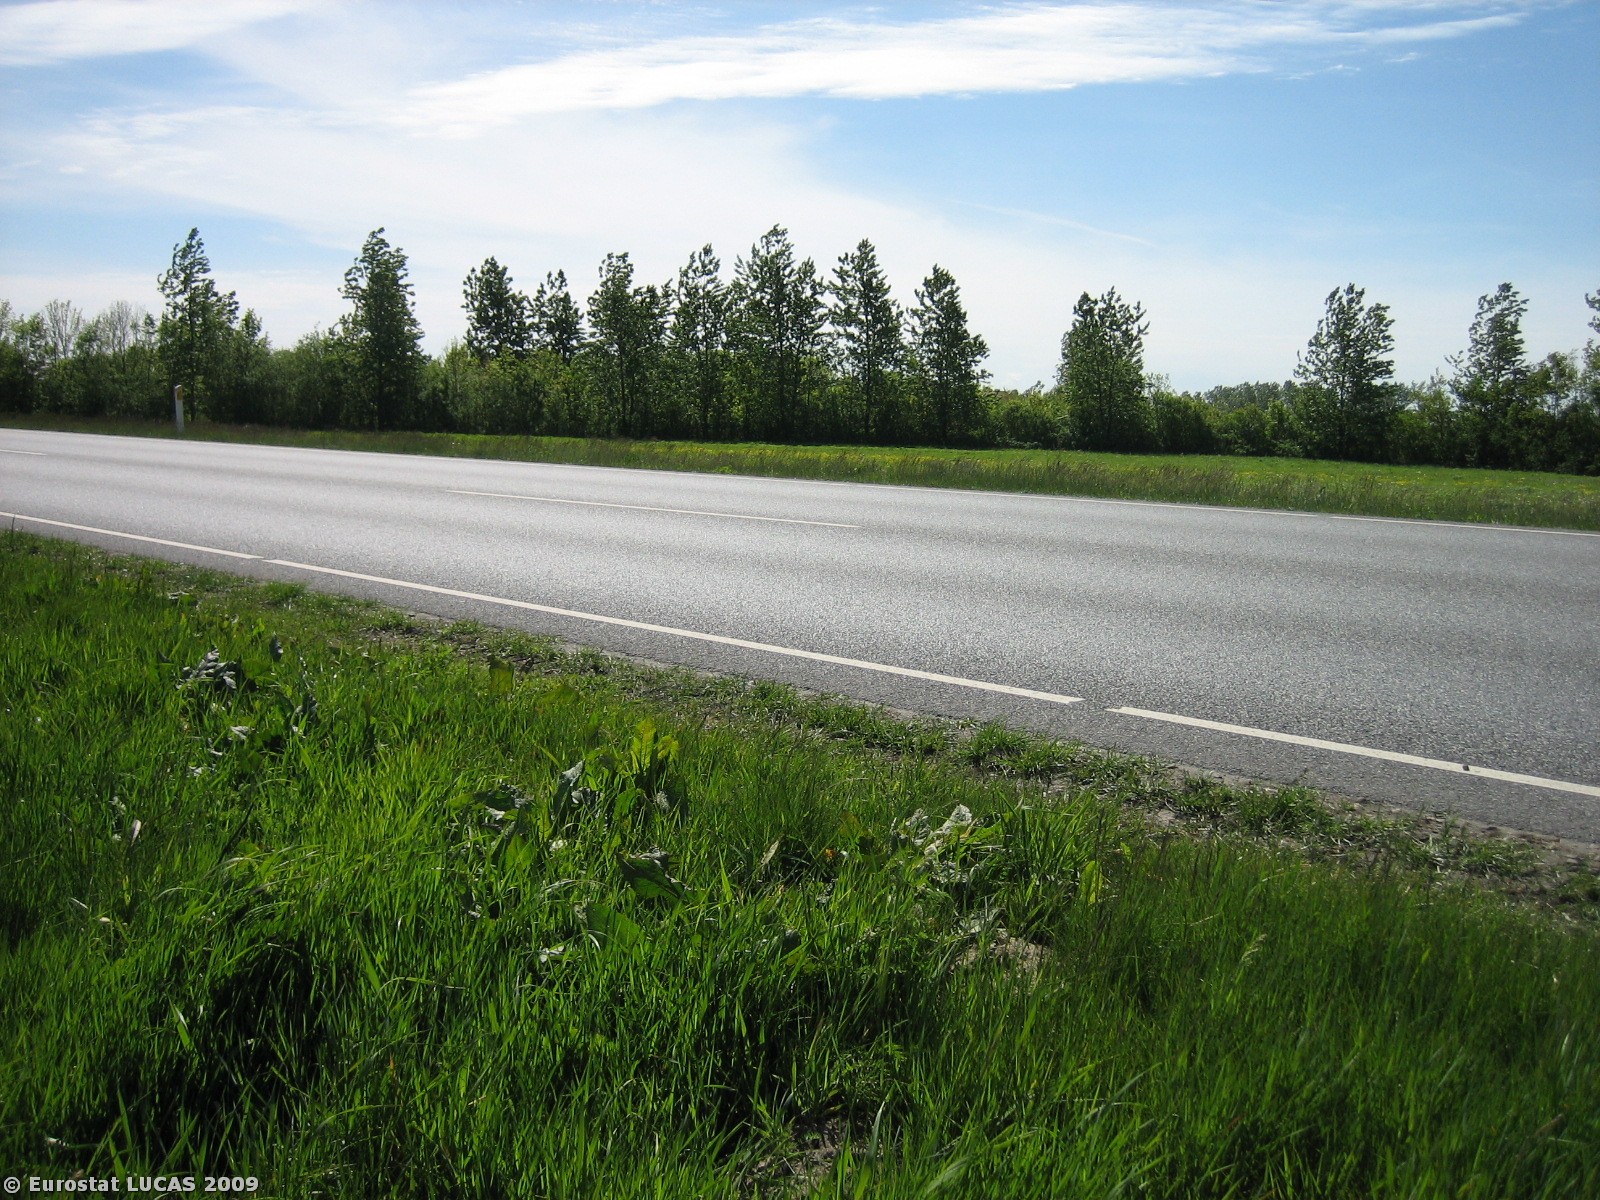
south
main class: Grassland
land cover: Grassland without tree/shrub cover
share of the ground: > 75 %
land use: Unused
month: May
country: DK
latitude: 55.9630
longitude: 8.4797
